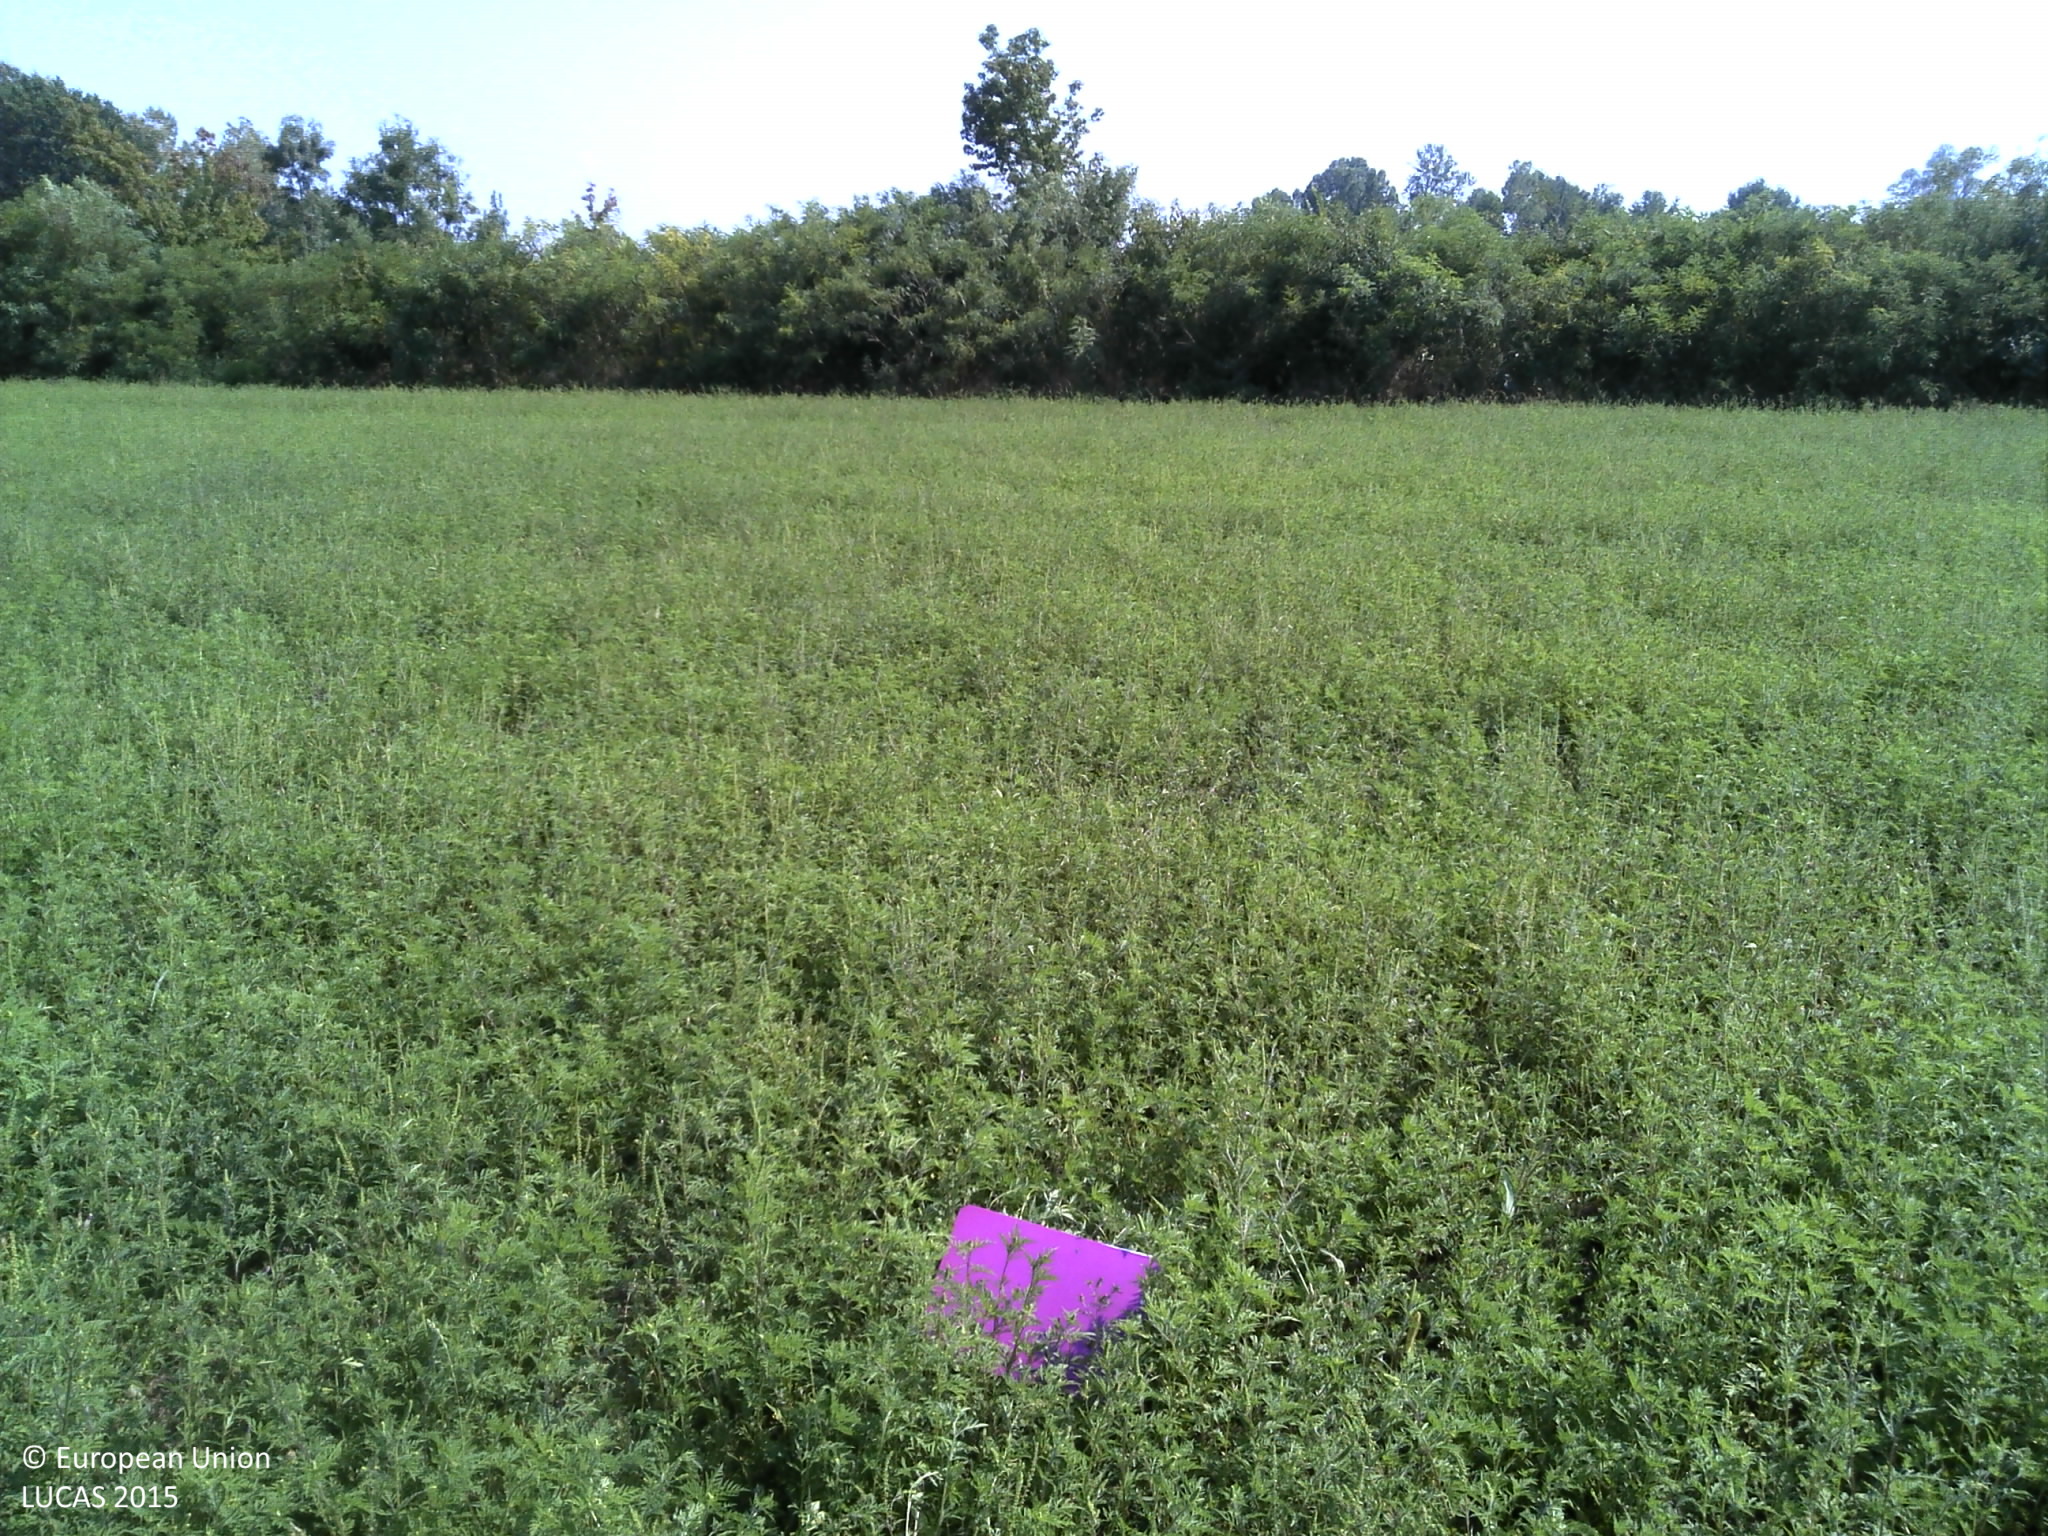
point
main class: Grassland
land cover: Spontaneously vegetated surfaces
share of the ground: > 75 %
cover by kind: herbaceous plants 100 %
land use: Fallow land
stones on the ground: < 10 %
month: August
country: HR
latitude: 45.2064
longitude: 17.1671
